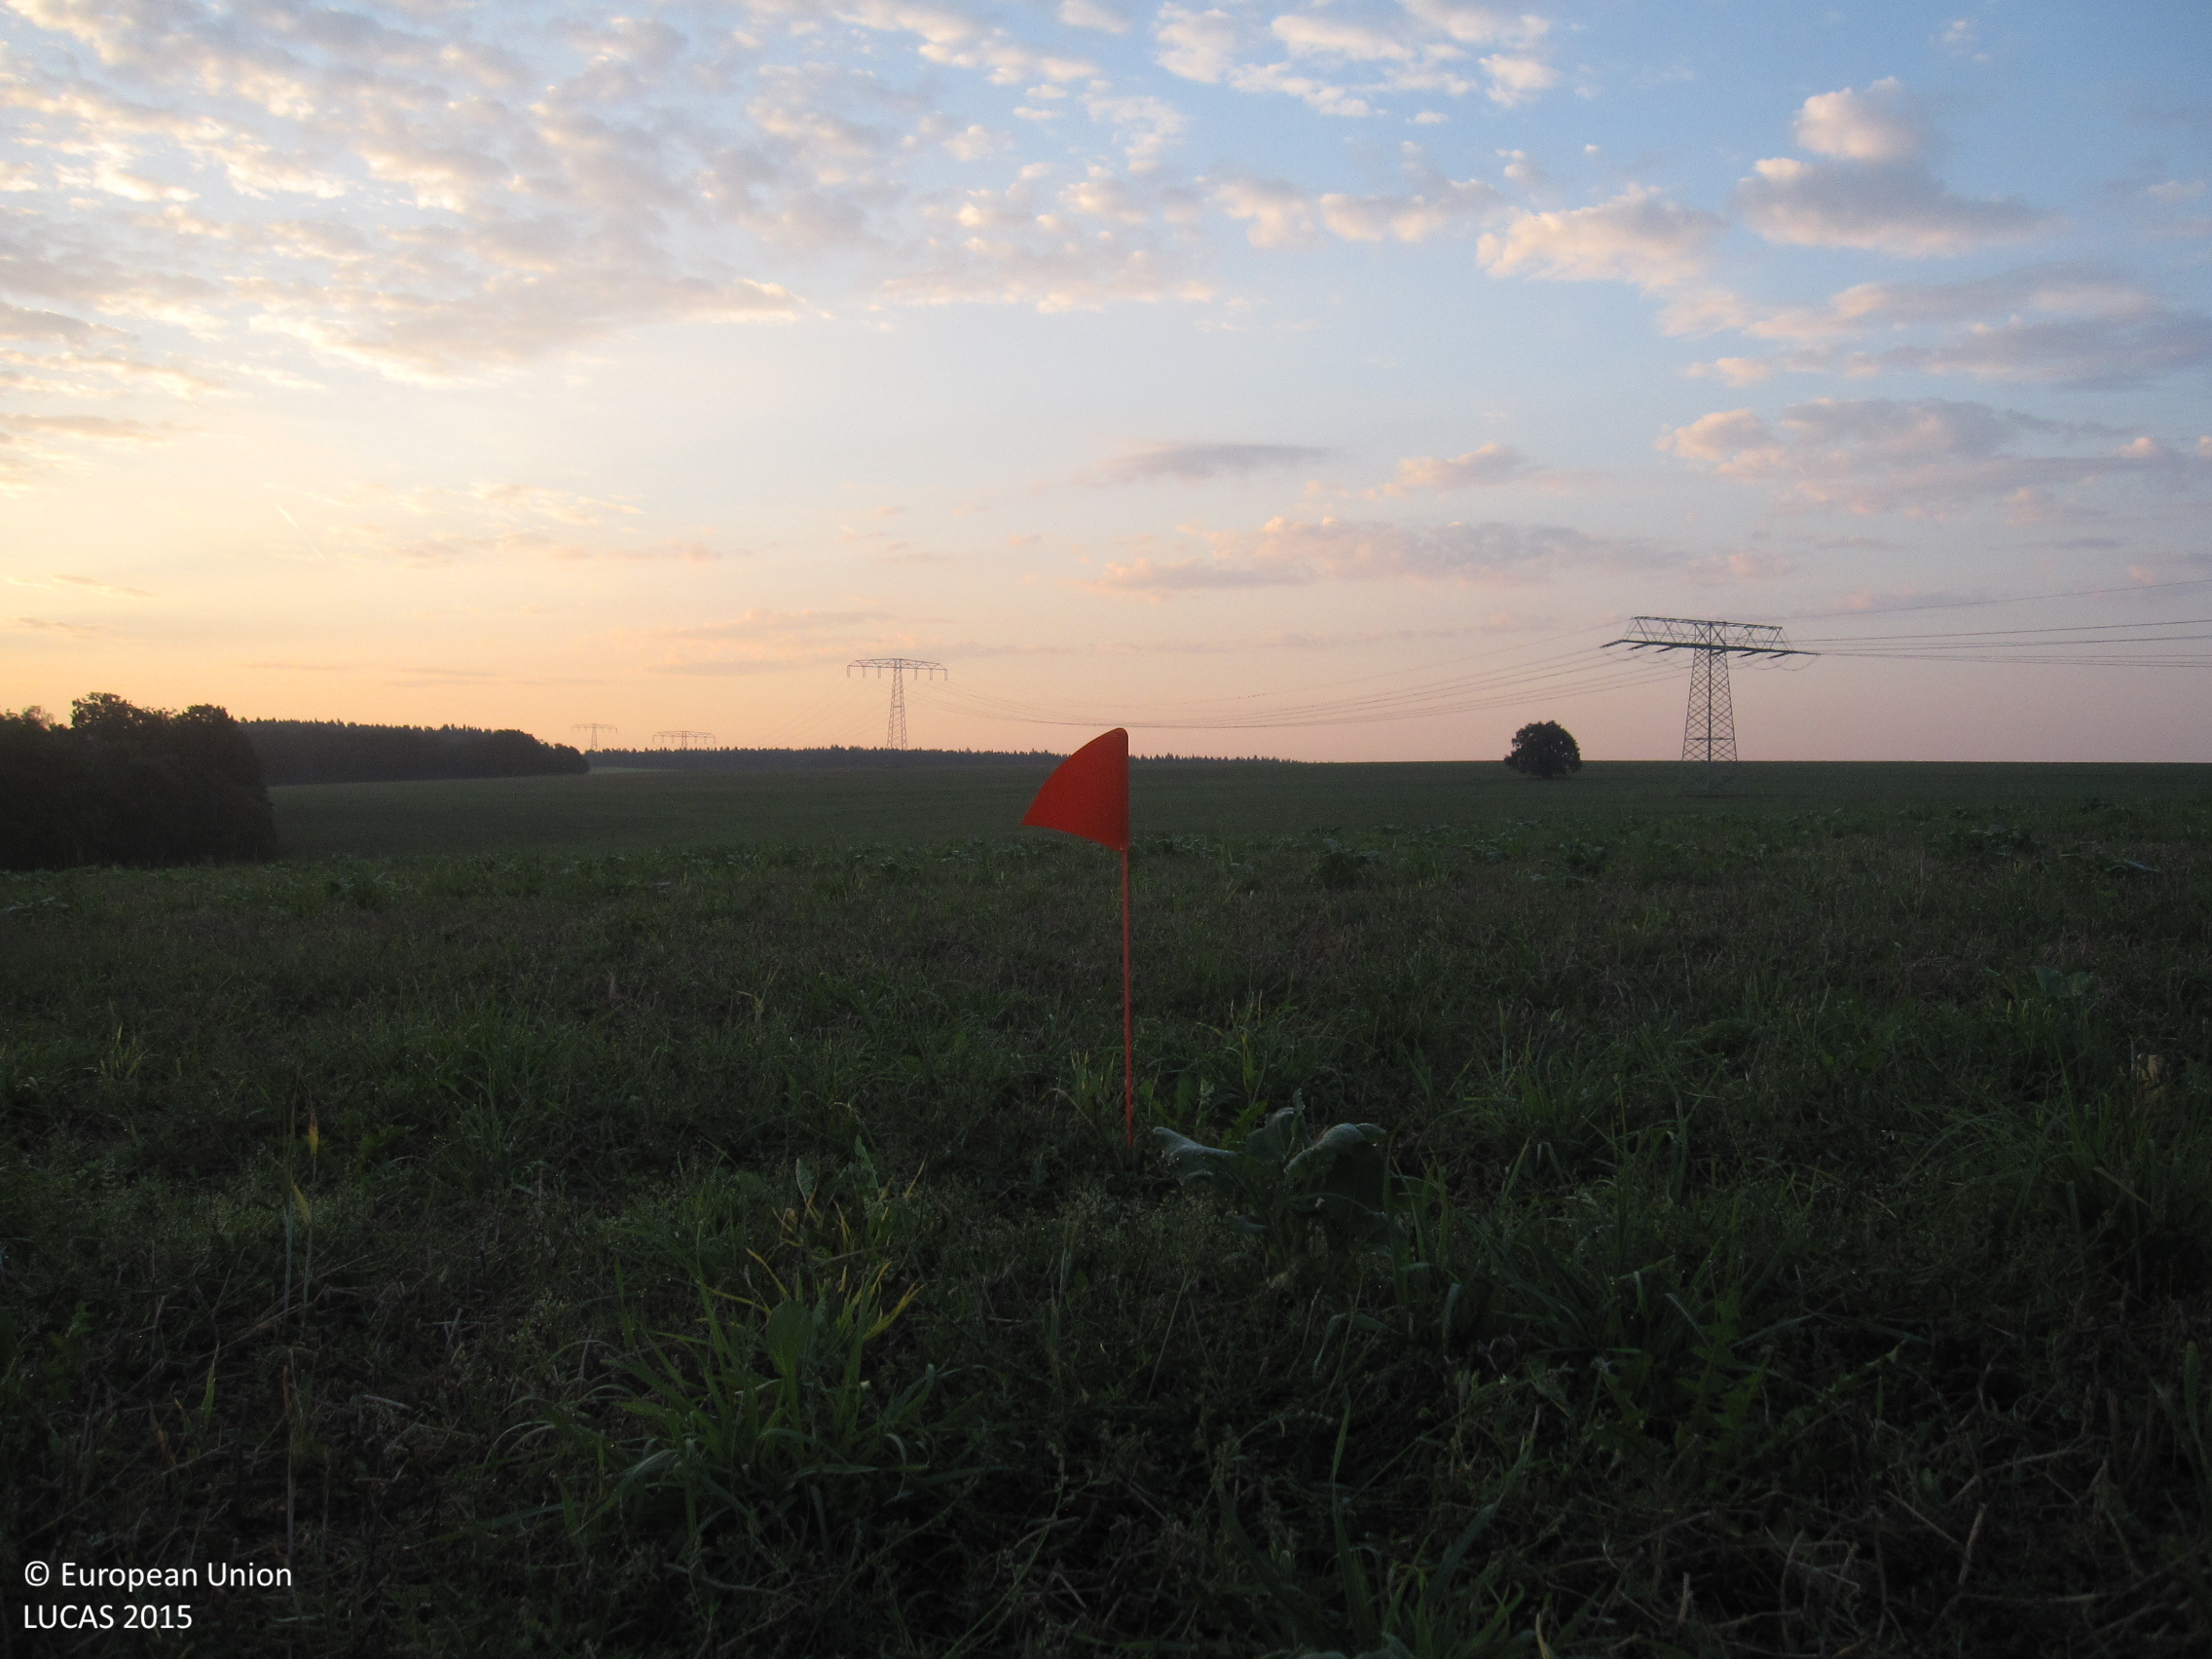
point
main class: Grassland
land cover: Grassland without tree/shrub cover
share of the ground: > 75 %
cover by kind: herbaceous plants 80 %, unconsolidated bare surface 20 %
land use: Agriculture (excluding fallow land and kitchen gardens)
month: August
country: DE
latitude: 50.7762
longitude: 12.1127
